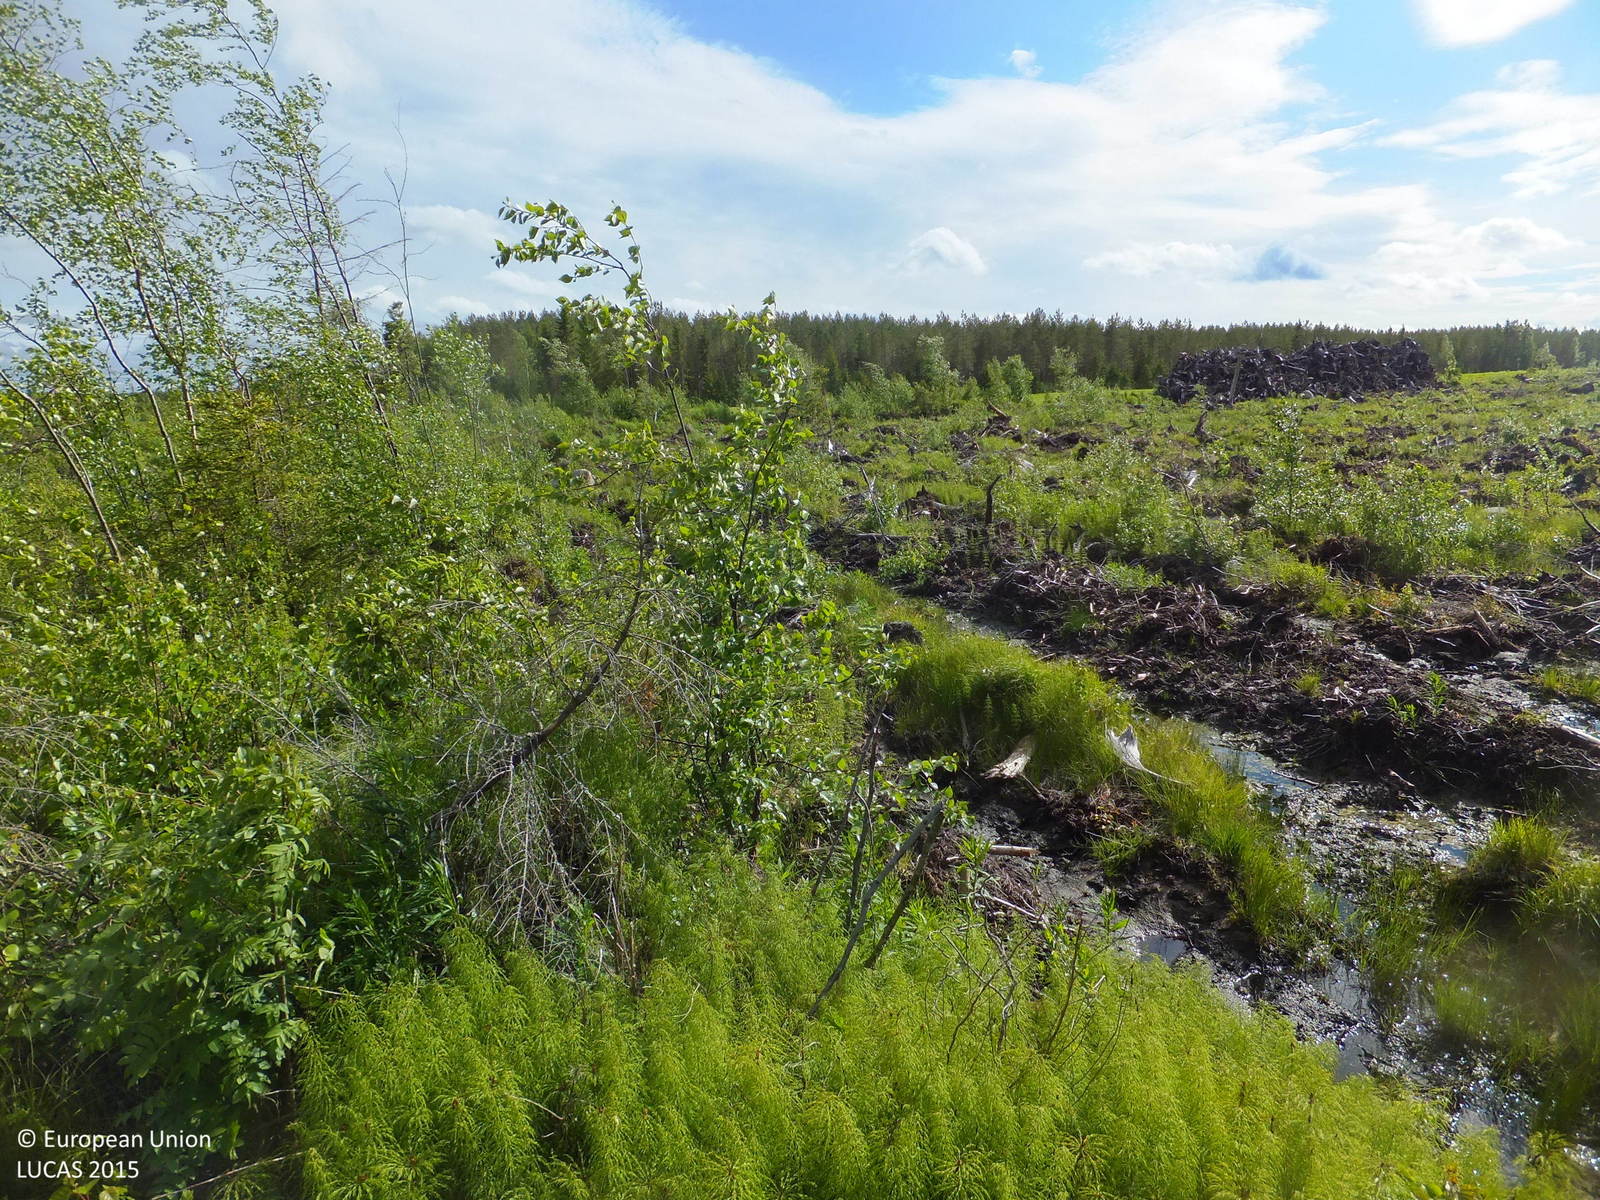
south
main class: Grassland
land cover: Spontaneously vegetated surfaces
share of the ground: 50 - 75 %
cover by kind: herbaceous plants 60 %, unconsolidated bare surface 35 %, shrubs 5 %
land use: Forestry
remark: Clear cut
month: June
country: FI
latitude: 63.2733
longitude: 22.7885
